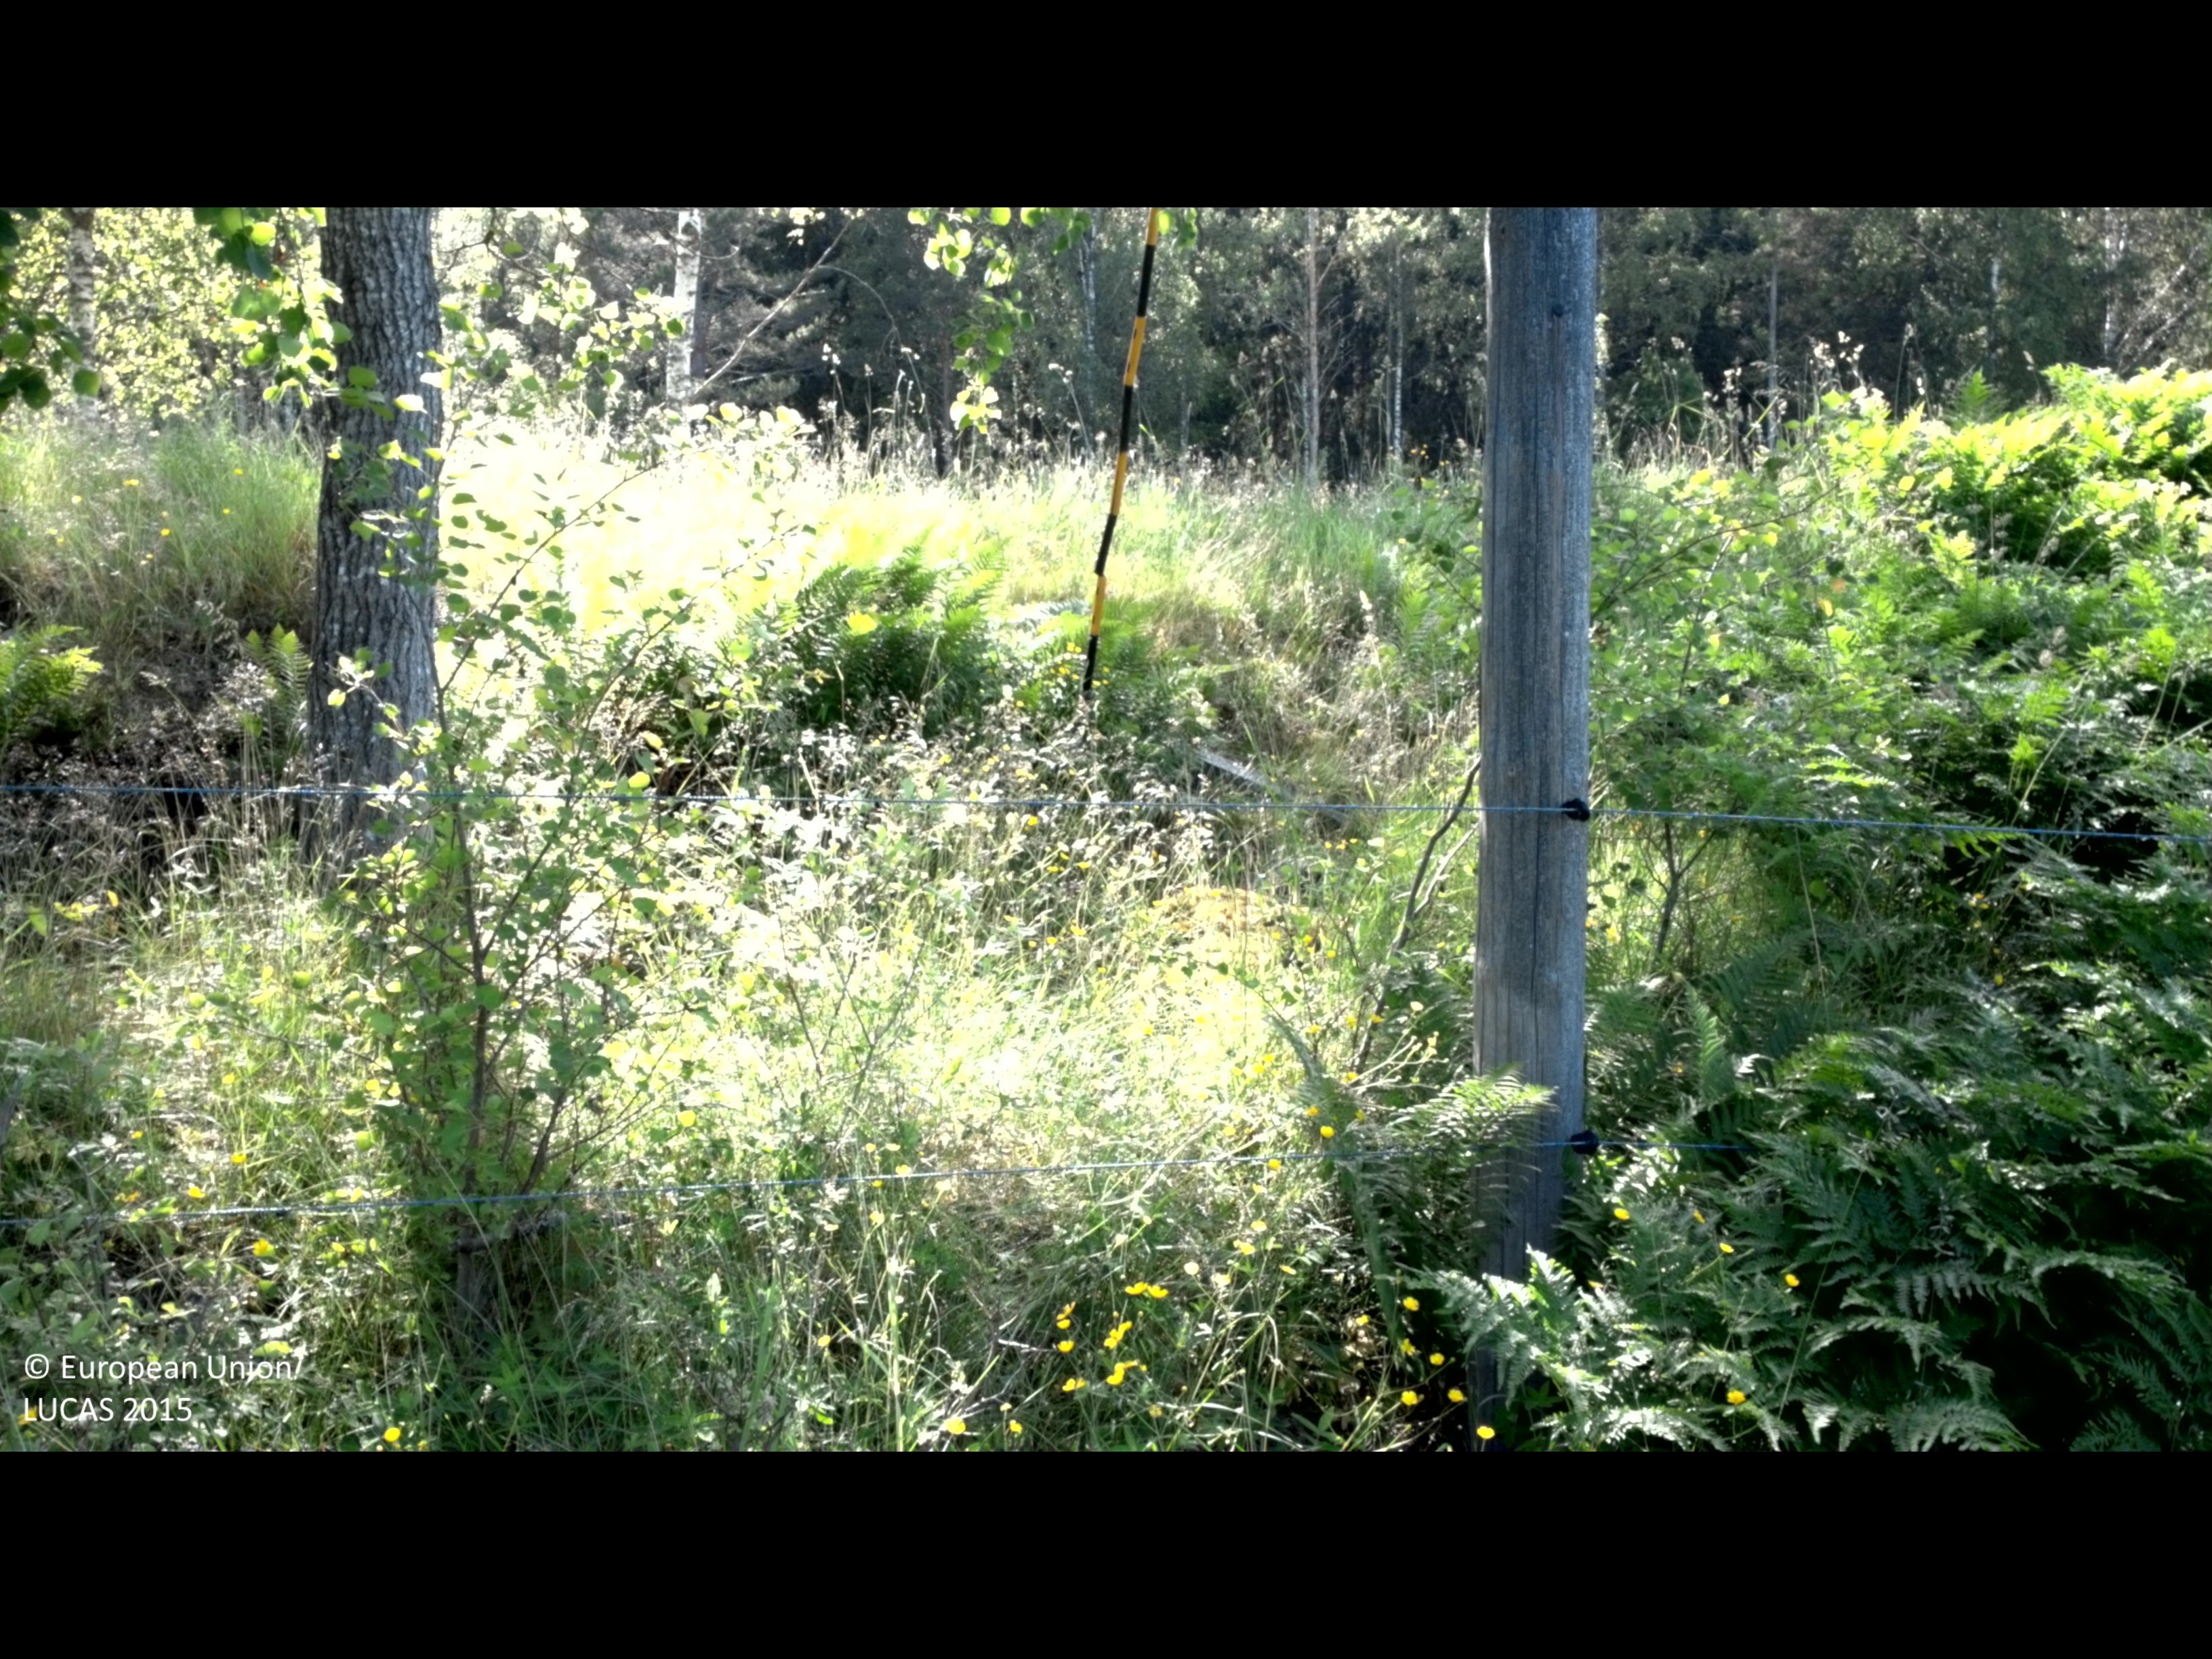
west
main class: Grassland
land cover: Grassland without tree/shrub cover
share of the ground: > 75 %
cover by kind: herbaceous plants 95 %, shrubs 5 %
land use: Agriculture (excluding fallow land and kitchen gardens)
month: June
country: SE
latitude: 58.2040
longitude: 16.1731
